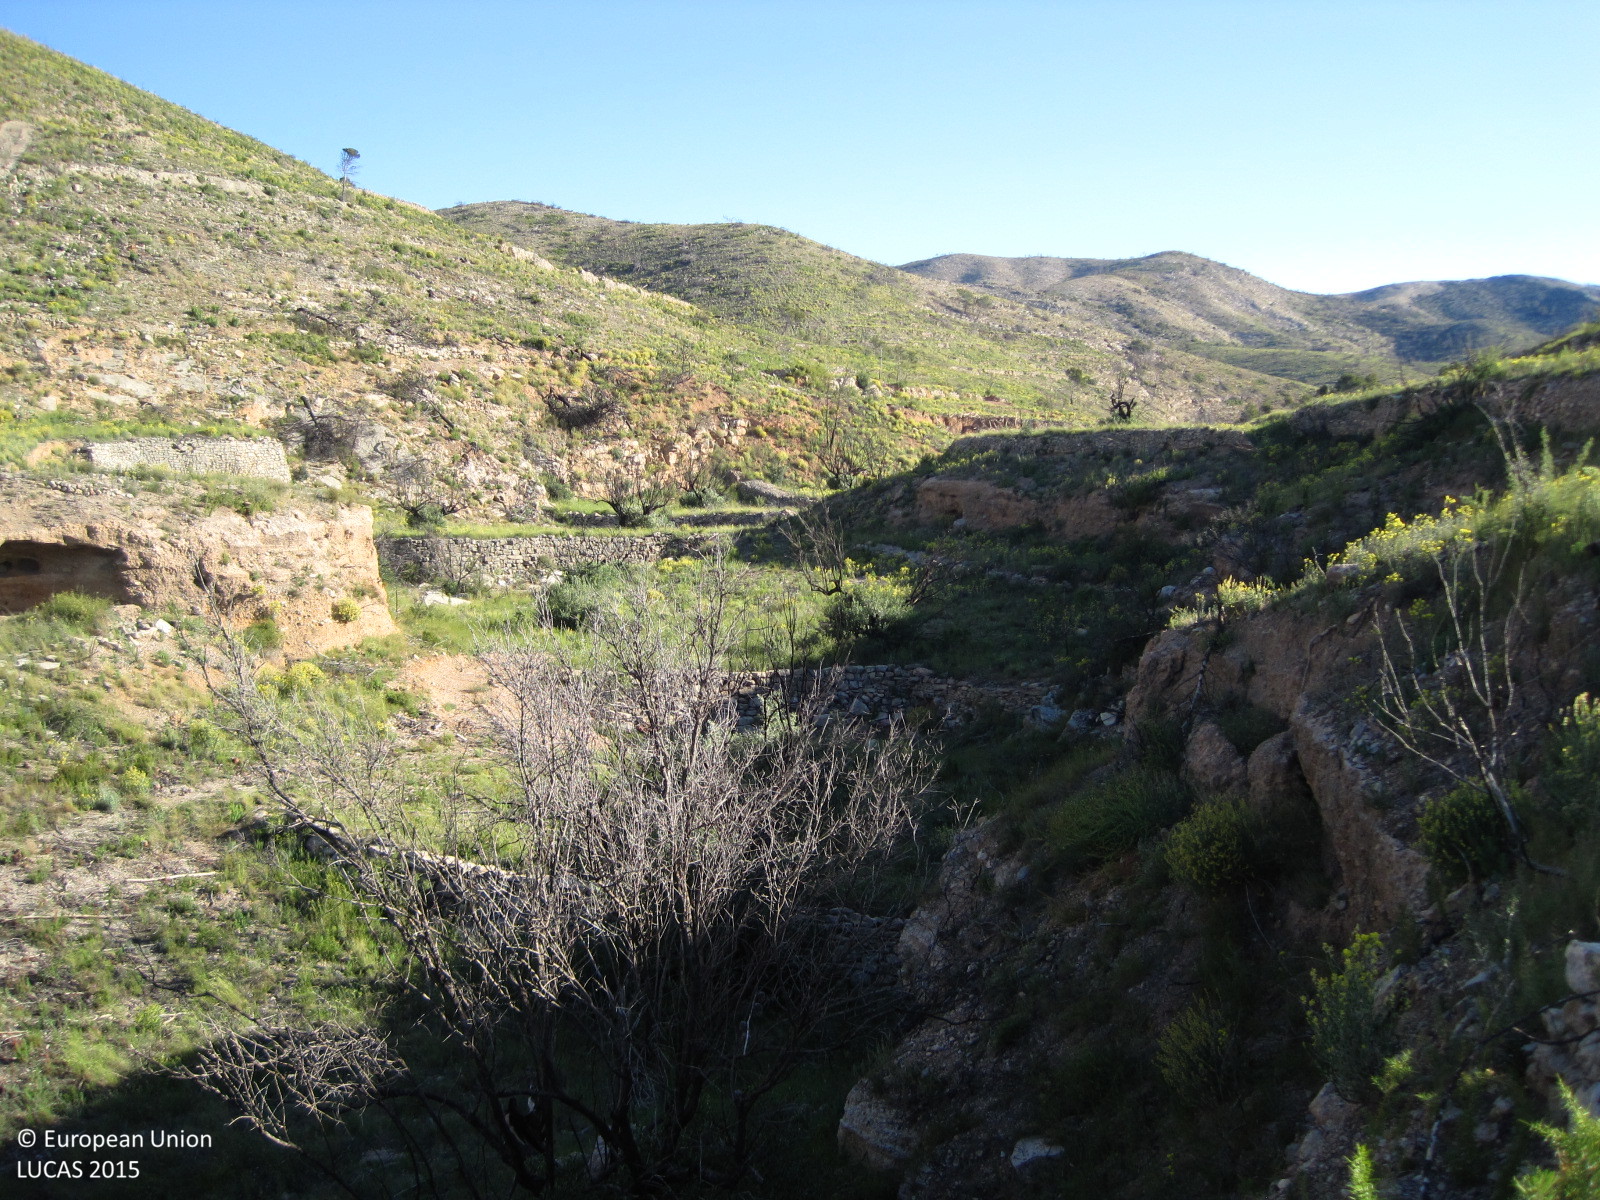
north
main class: Shrubland
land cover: Shrubland without tree cover
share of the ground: 25 - 50 %
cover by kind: shrubs 75 %, herbaceous plants 15 %, consolidated bare surface 5 %, unconsolidated bare surface 5 %
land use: Semi-natural and natural areas not in use
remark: Burnt area
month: May
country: ES
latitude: 39.7554
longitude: -0.6814
